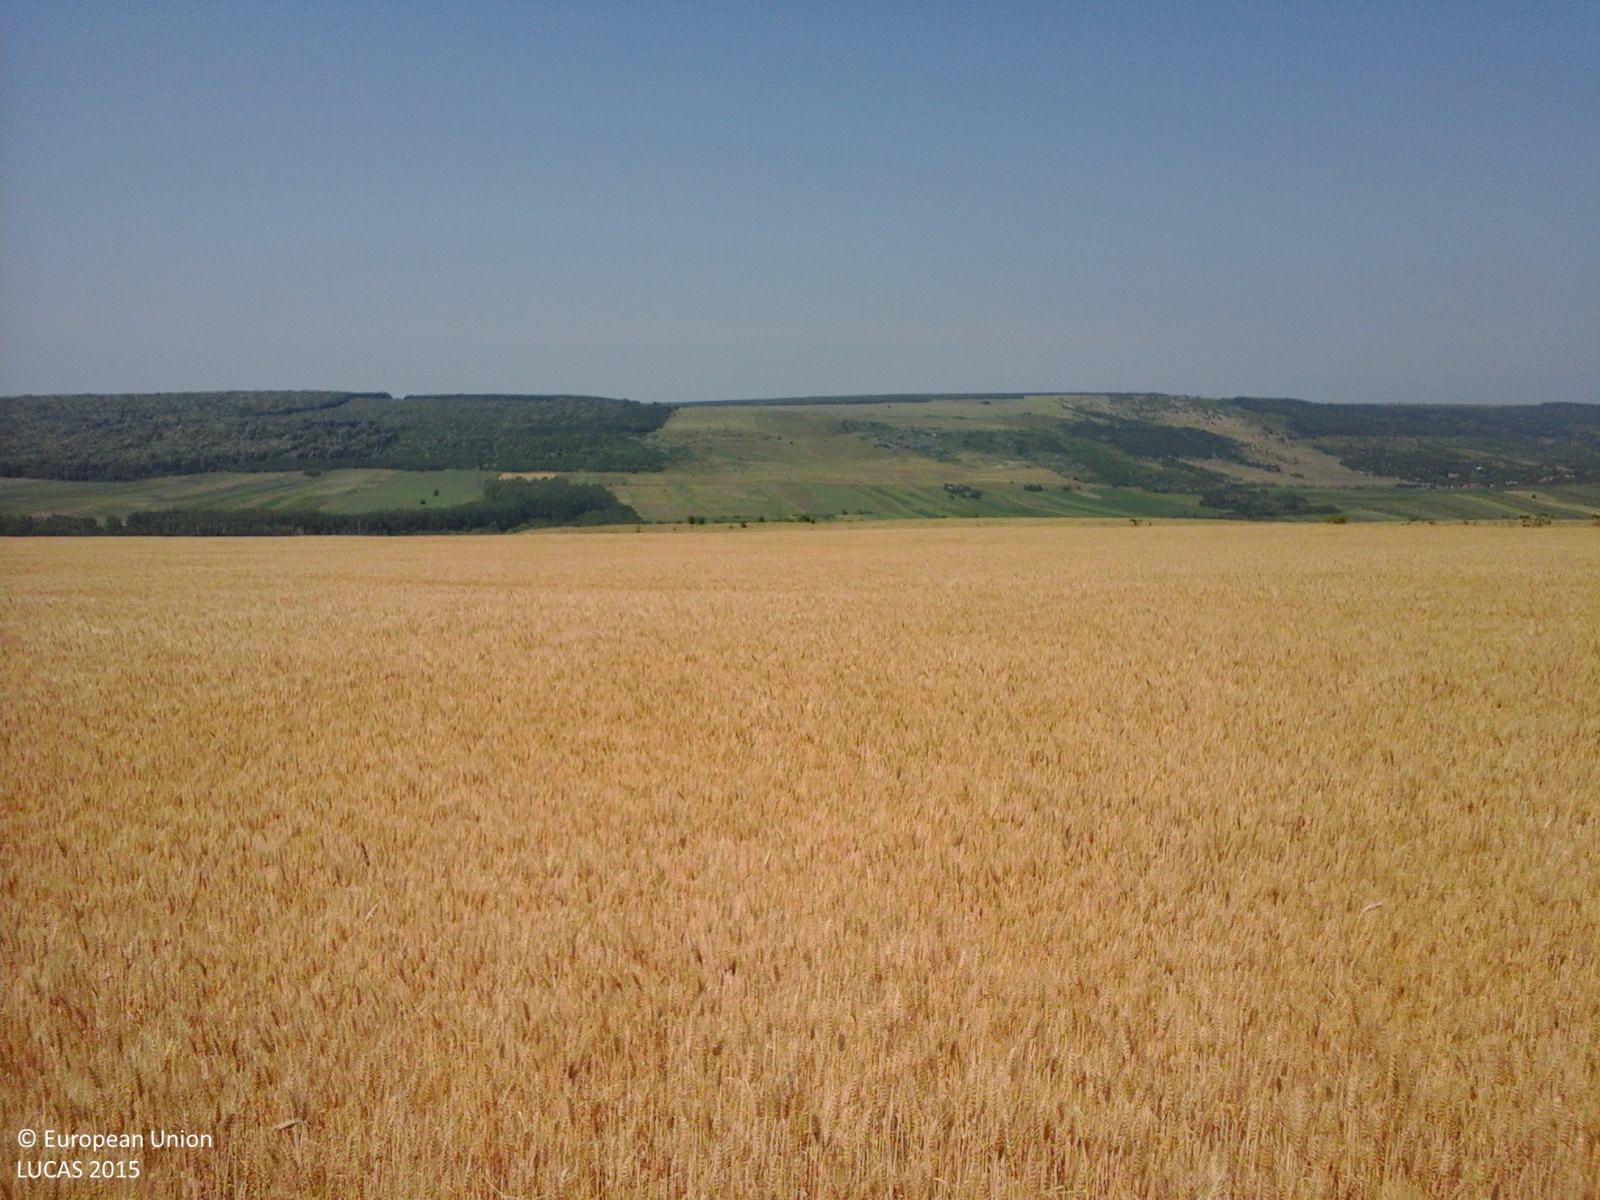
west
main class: Cropland
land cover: Common wheat
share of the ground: > 75 %
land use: Agriculture (excluding fallow land and kitchen gardens)
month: June
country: RO
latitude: 46.9575
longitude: 27.8250
